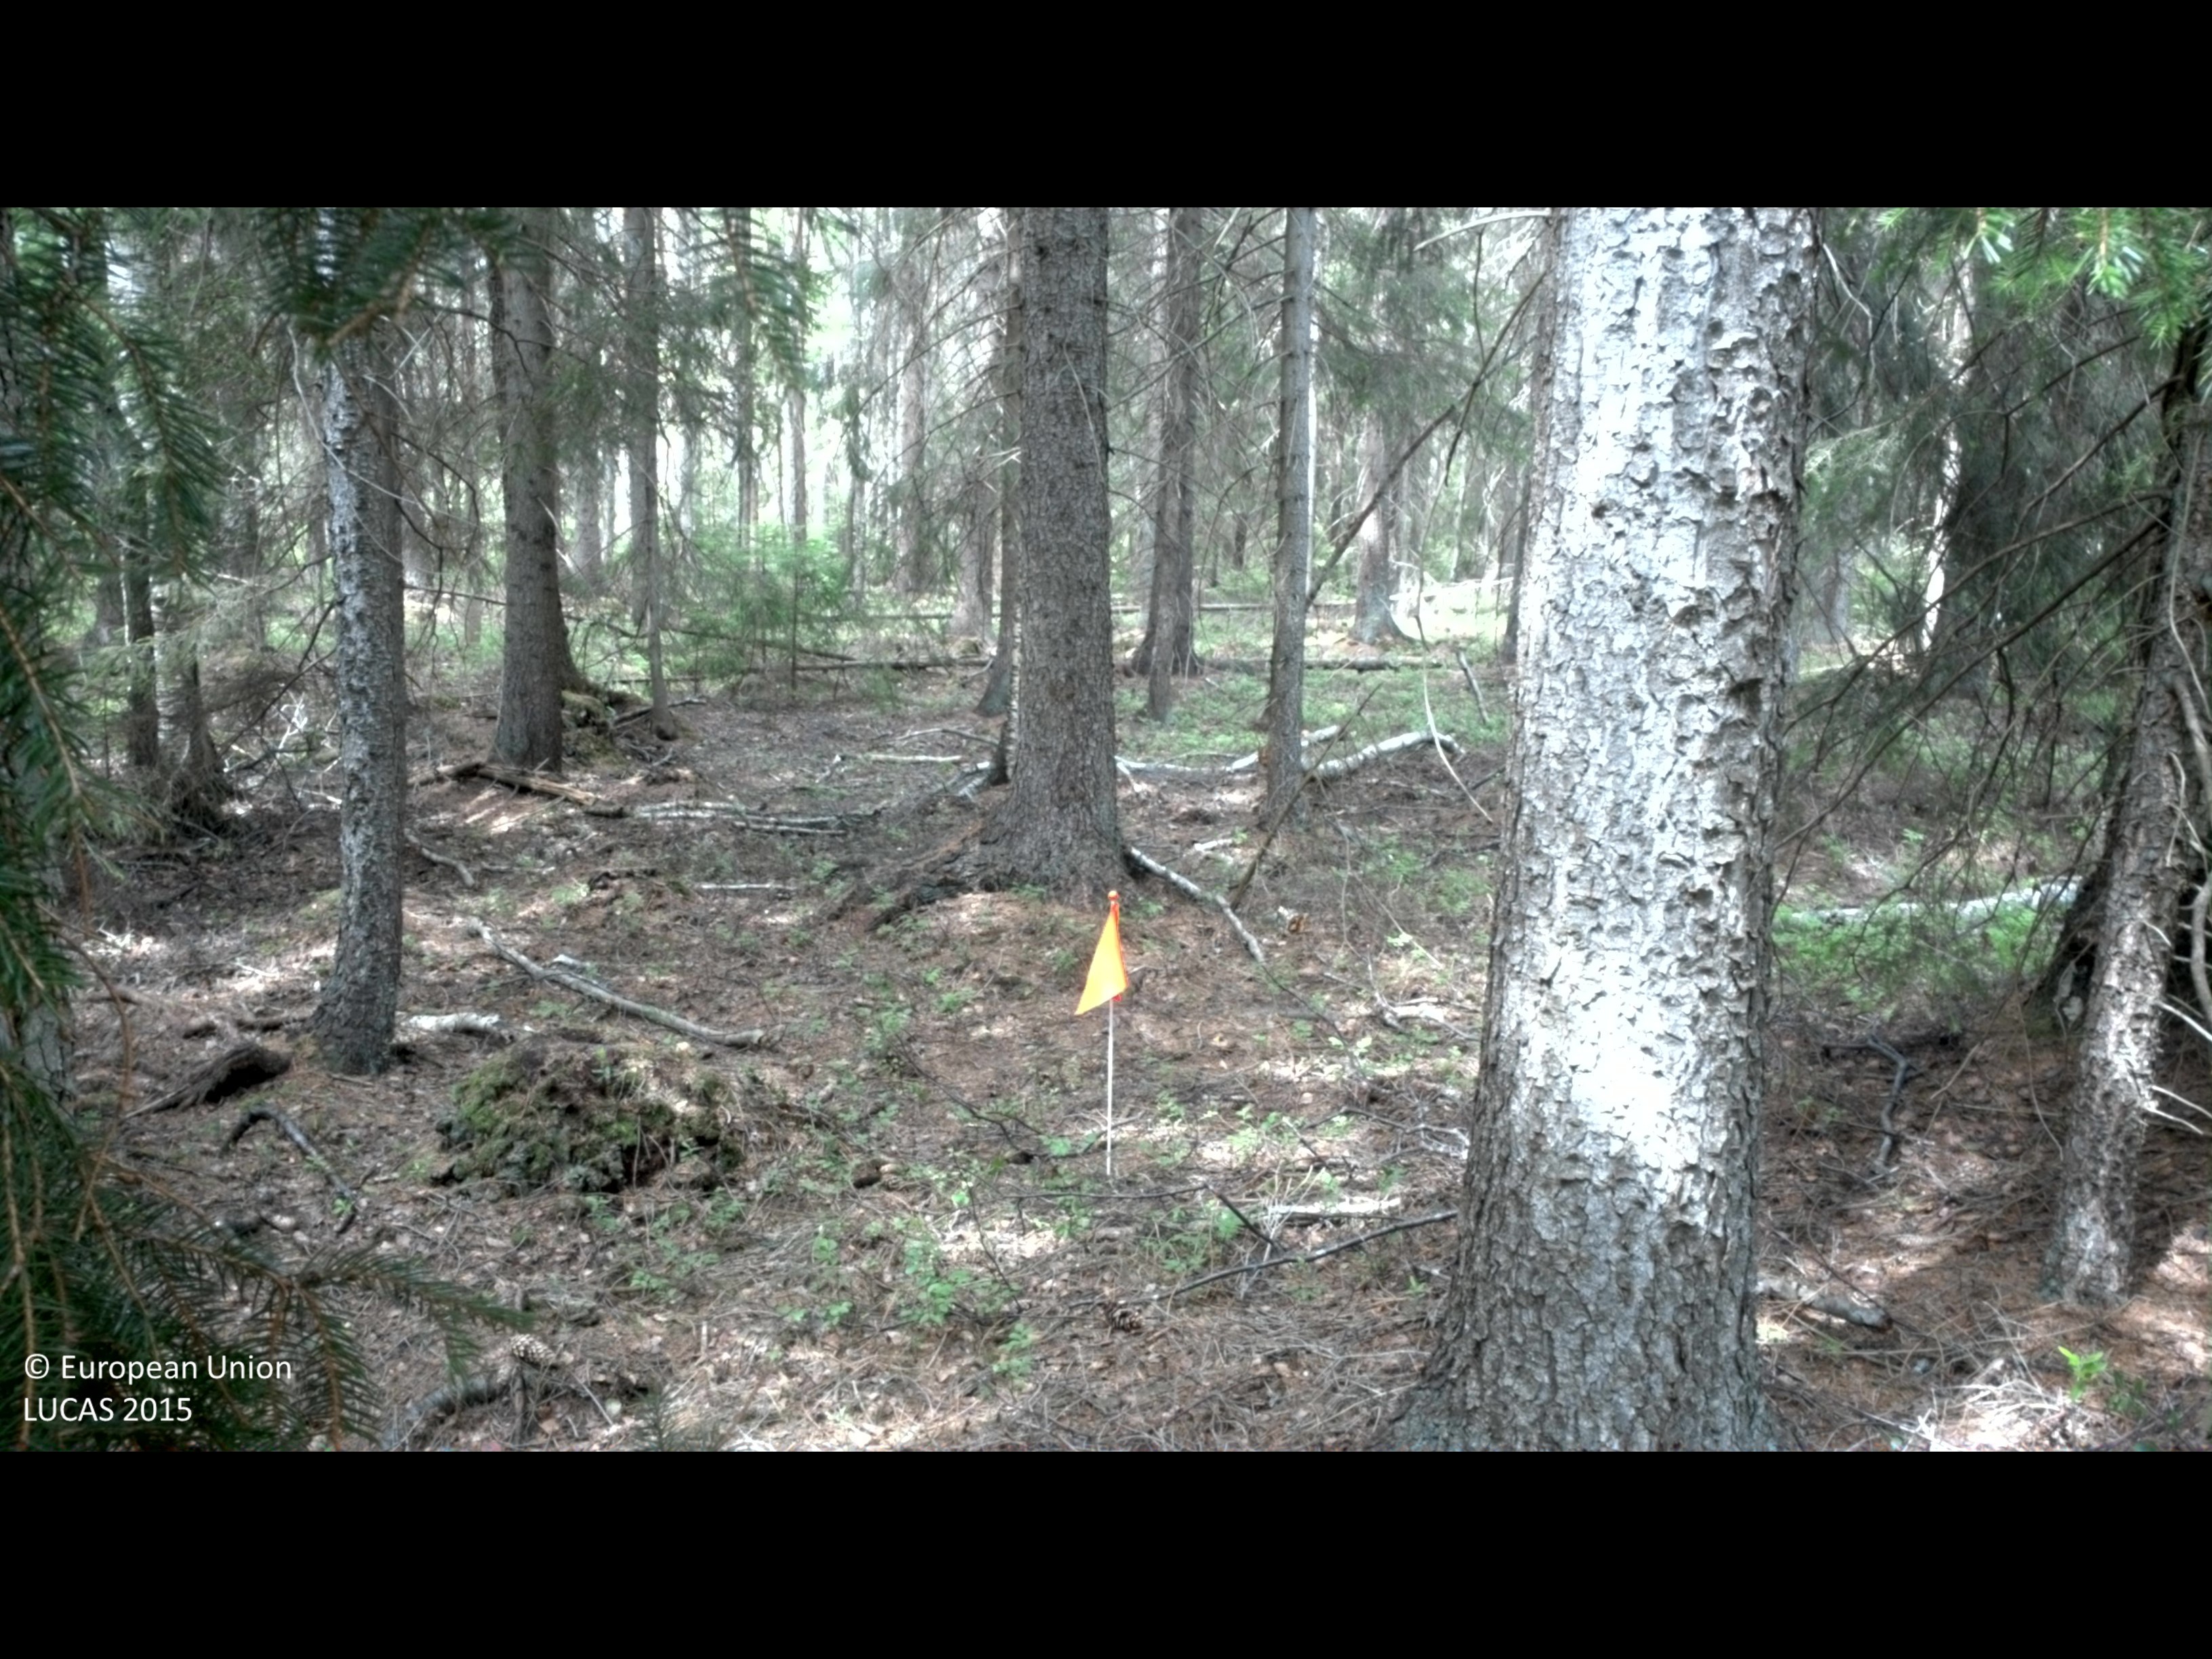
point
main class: Woodland
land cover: Spruce dominated coniferous woodland
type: boreal forest
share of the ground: > 75 %
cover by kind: coniferous forest trees 70 %, broadleaved forest trees 20 %, shrubs 10 %
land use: Forestry
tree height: > 5 m
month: June
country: SE
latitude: 57.9488
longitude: 16.6042
